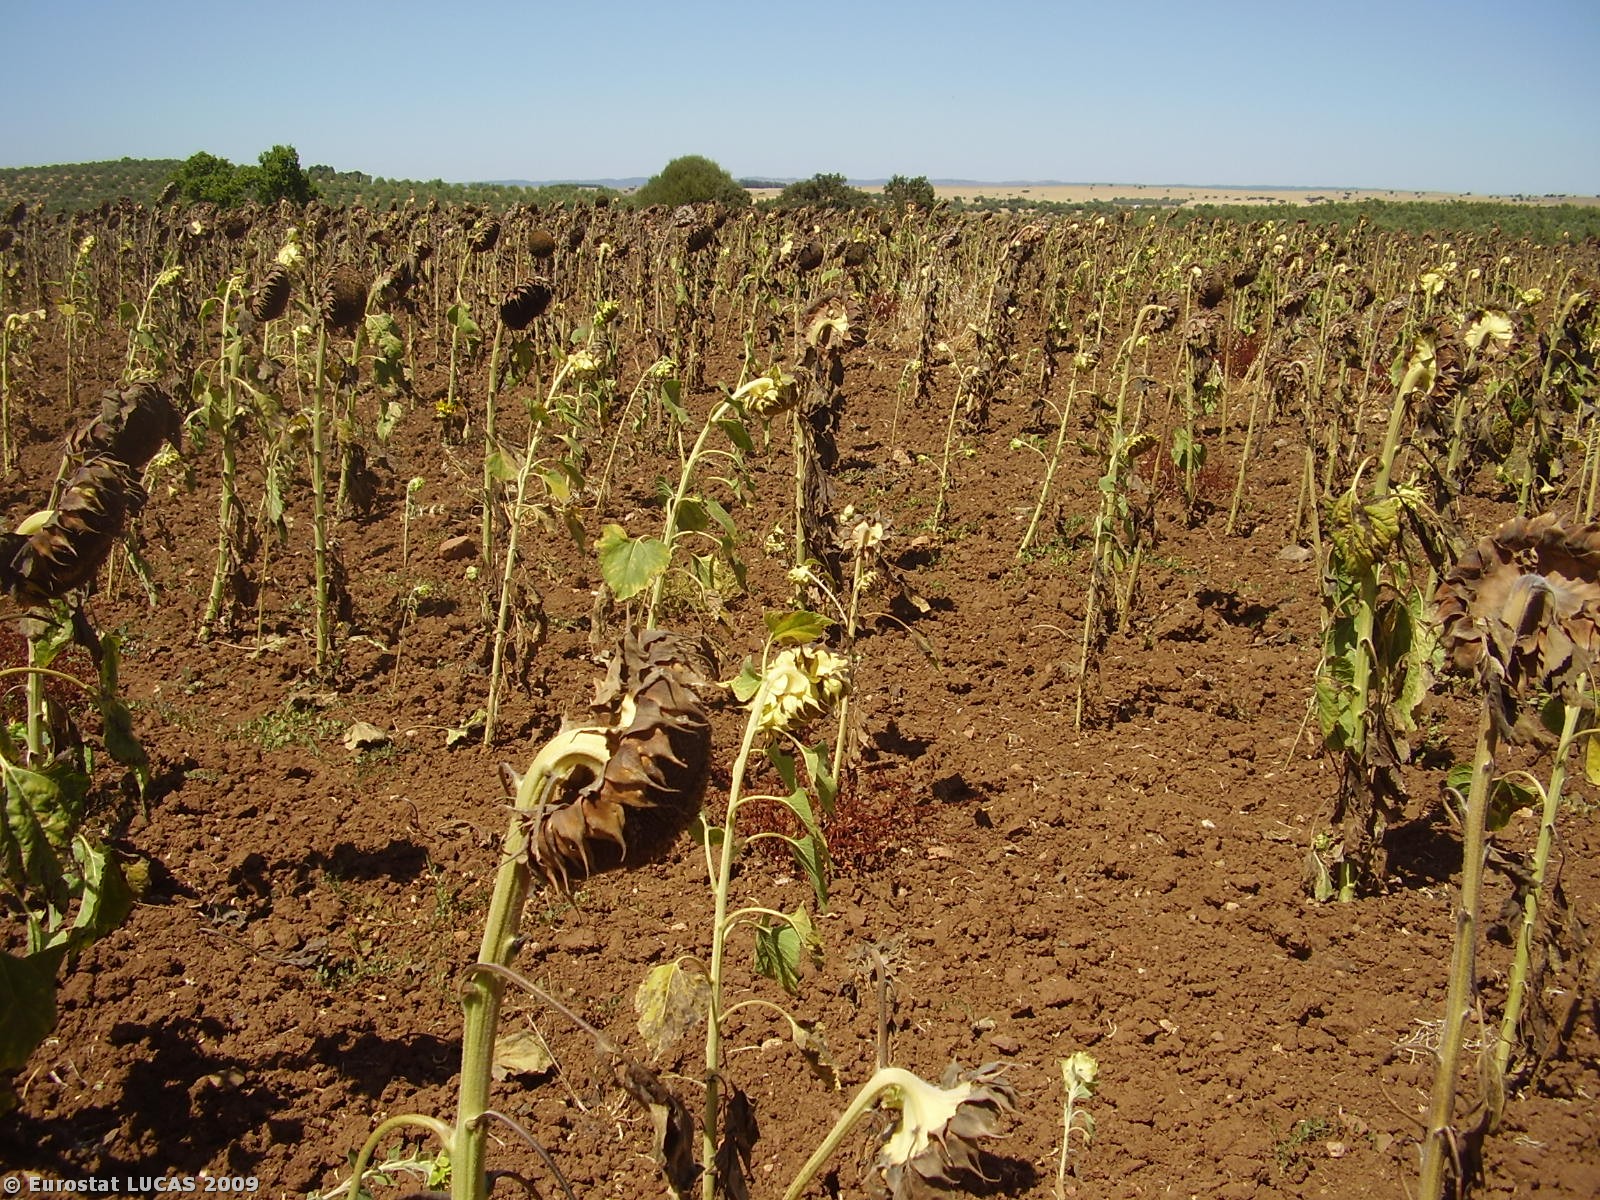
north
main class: Cropland
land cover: Sunflower
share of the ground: 10 - 25 %
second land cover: Spontaneously vegetated surfaces
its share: < 10 %
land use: Agriculture (excluding fallow land and kitchen gardens)
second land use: Fallow land
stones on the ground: < 10 %
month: July
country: PT
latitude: 38.0270
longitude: -7.8331
